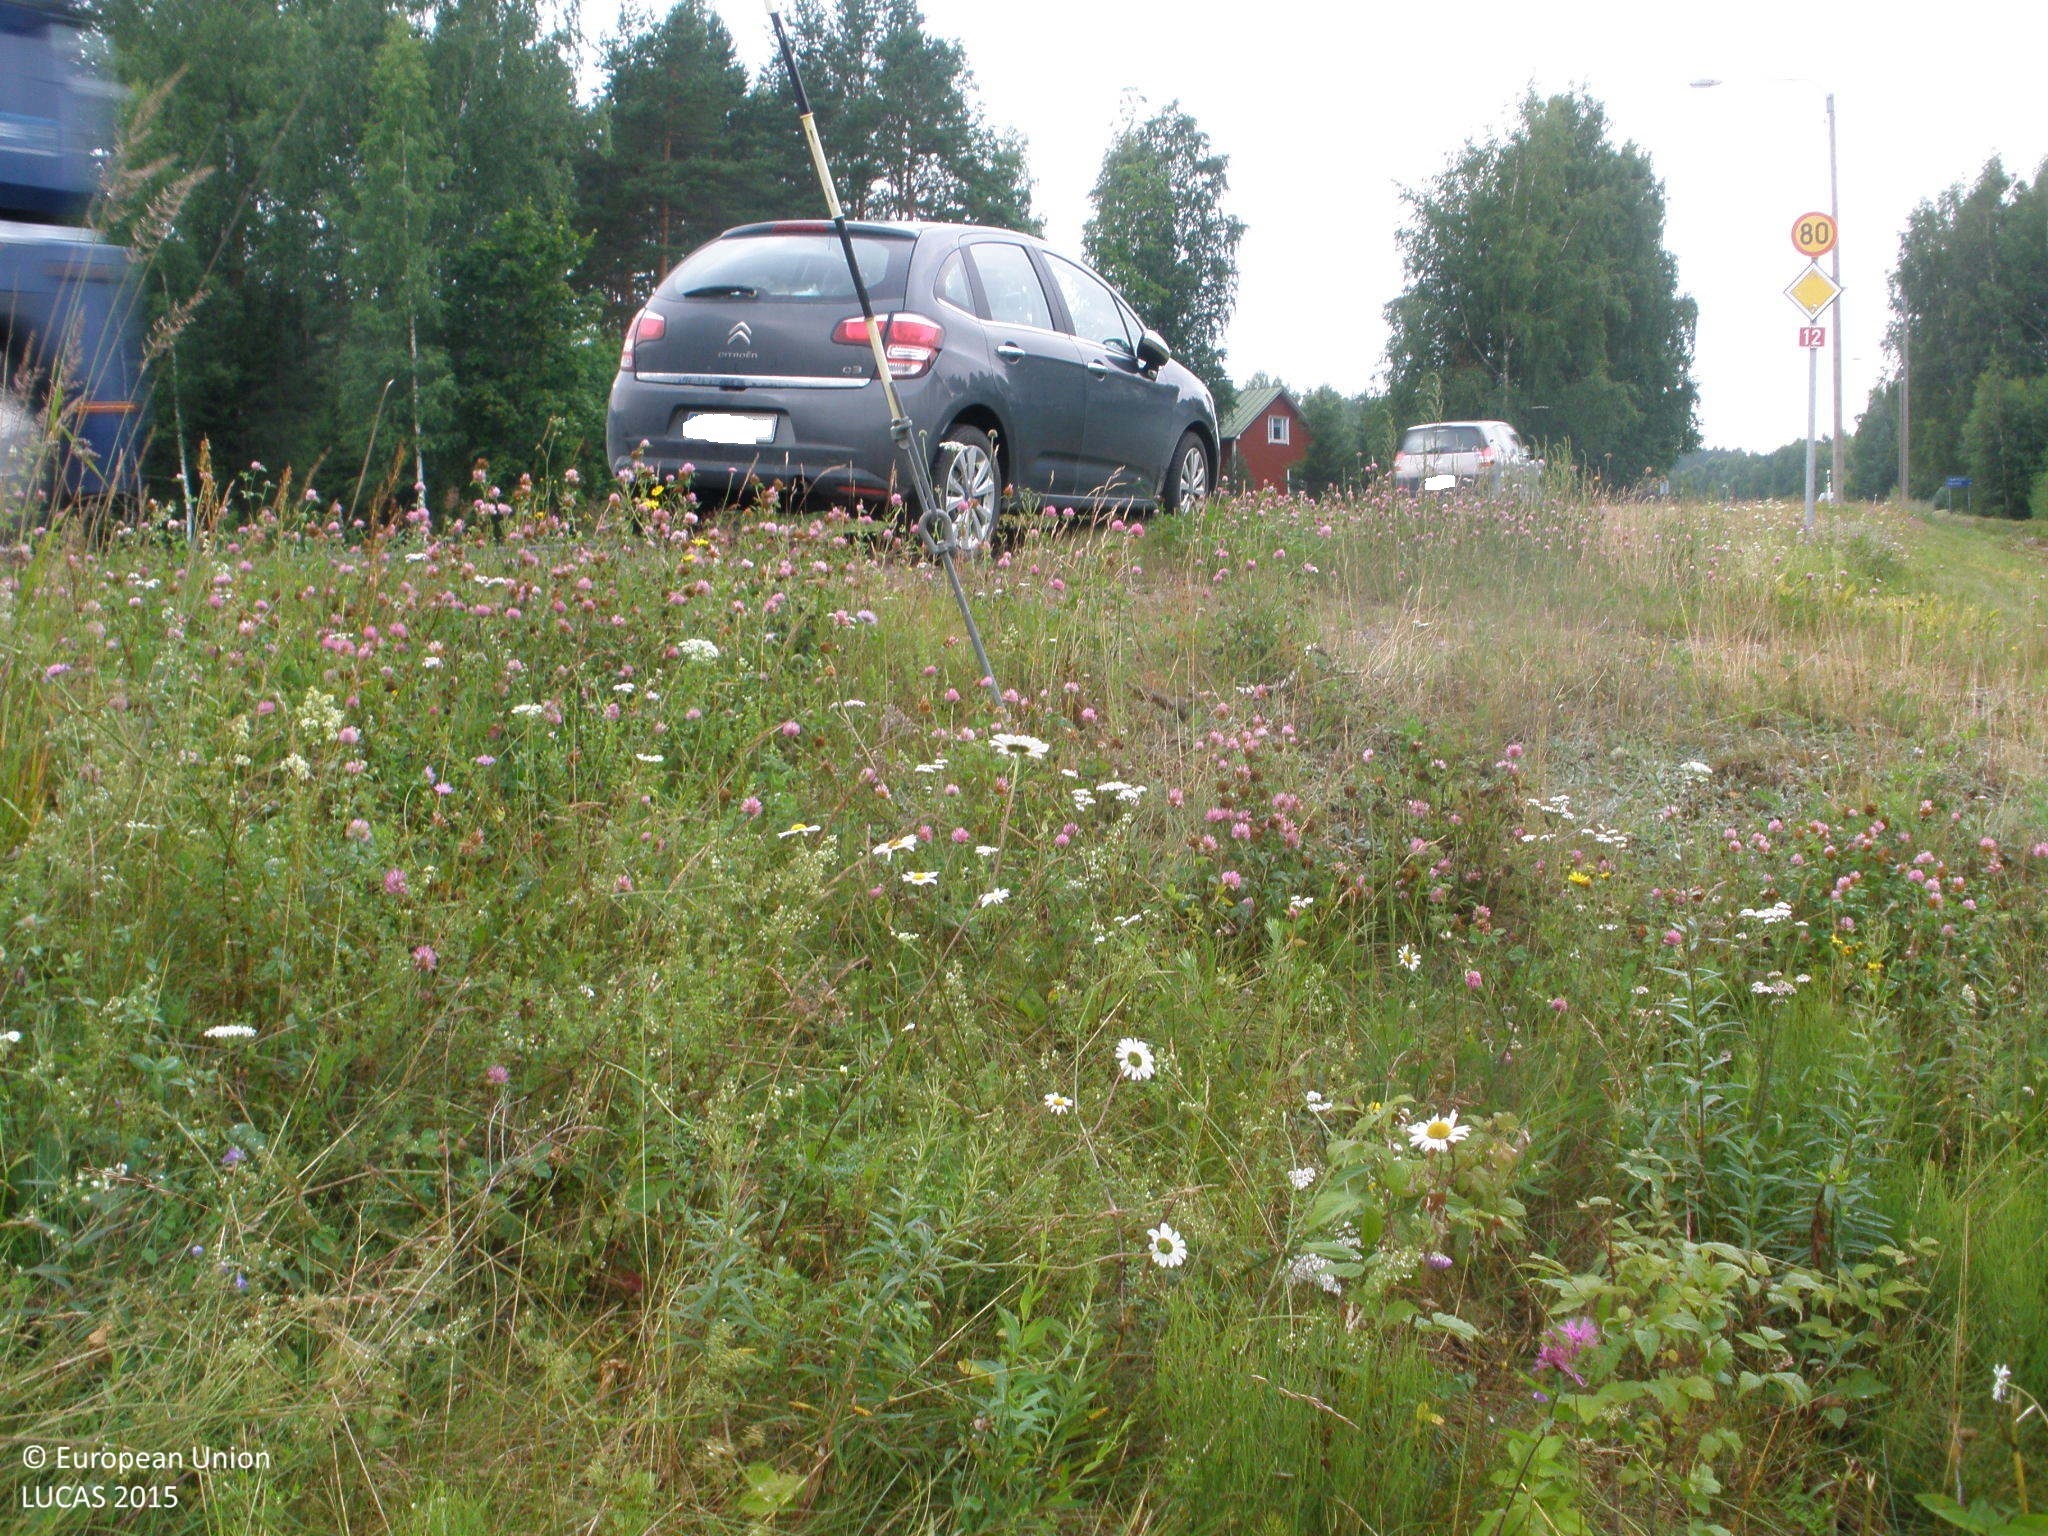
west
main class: Grassland
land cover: Grassland without tree/shrub cover
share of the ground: > 75 %
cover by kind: herbaceous plants 100 %
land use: Road transport
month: July
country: FI
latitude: 61.1393
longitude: 24.7985
